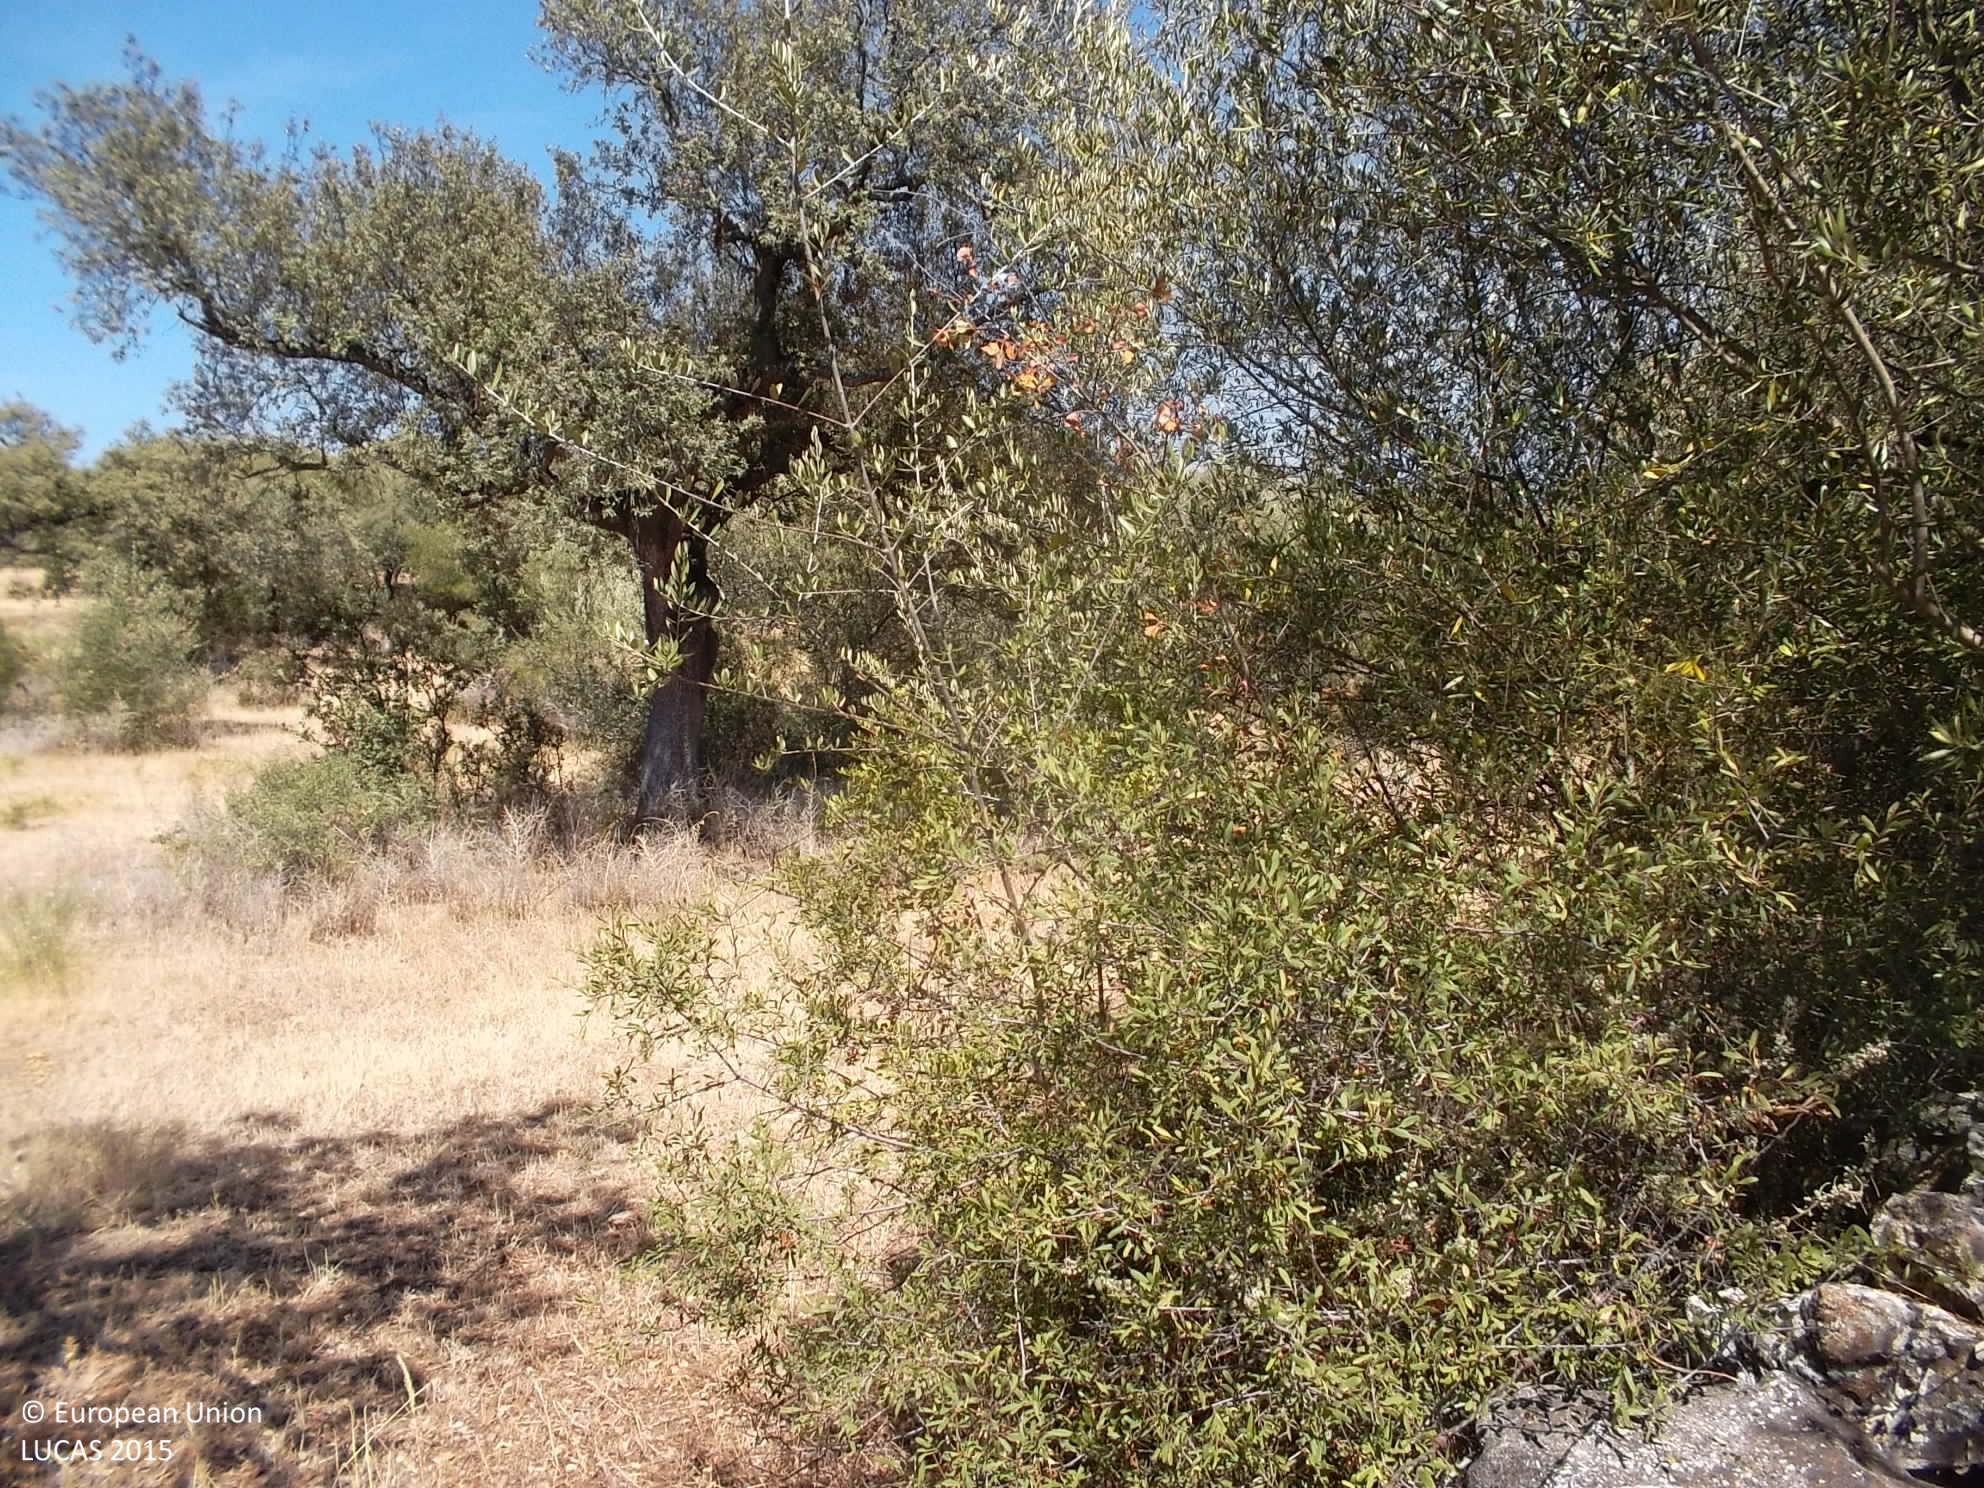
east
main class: Woodland
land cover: Broadleaved woodland
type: broadleaved evergreen forest
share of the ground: 25 - 50 %
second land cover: Grassland without tree/shrub cover
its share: > 75 %
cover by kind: herbaceous plants 55 %, broadleaved forest trees 35 %, shrubs 10 %
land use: Forestry
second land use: Agriculture (excluding fallow land and kitchen gardens)
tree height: < 5 m
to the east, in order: Broadleaved woodland; Grassland without tree/shrub cover; Abandoned hedges; Dry stone walls; Grassland without tree/shrub cover; Abandoned hedges; Dry stone walls; Grassland with sparse tree/shrub cover
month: August
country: ES
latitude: 38.3330
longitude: -6.5593
